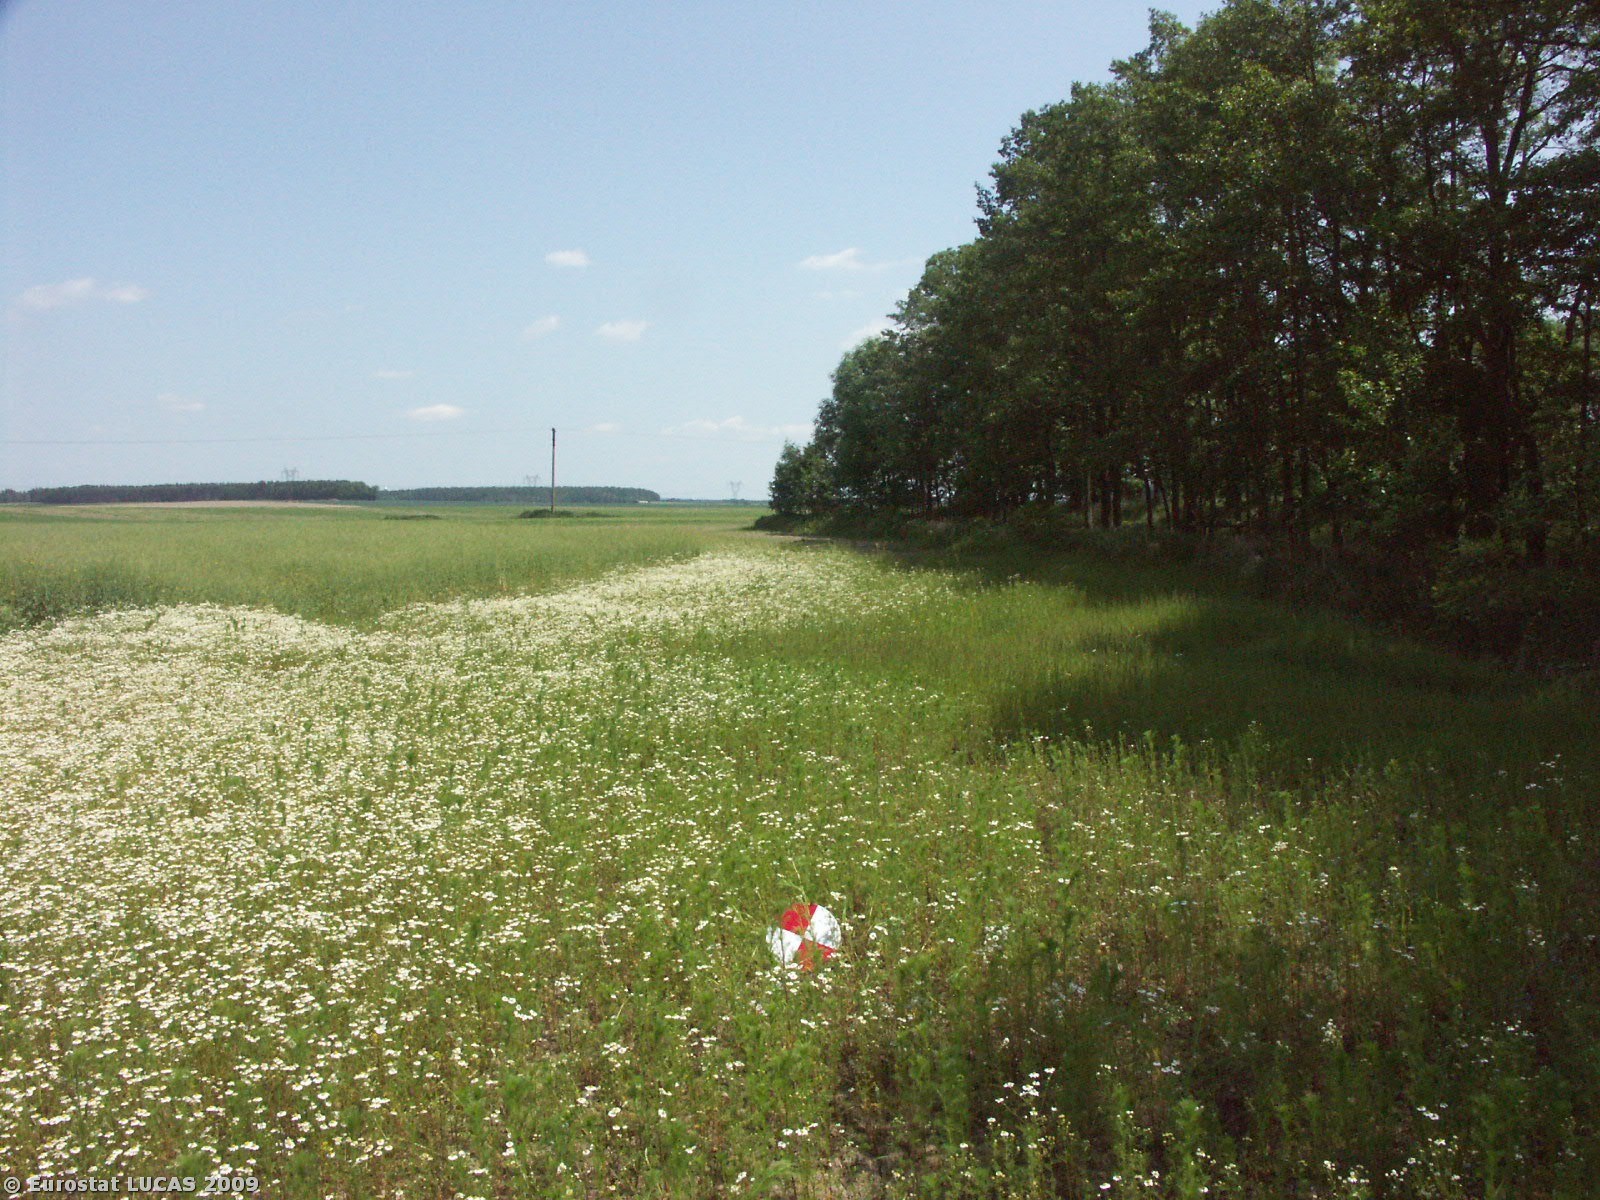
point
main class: Grassland
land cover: Spontaneously vegetated surfaces
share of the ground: > 75 %
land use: Fallow land
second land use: Nature reserves
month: May
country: CZ
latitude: 49.0966
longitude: 14.6991
